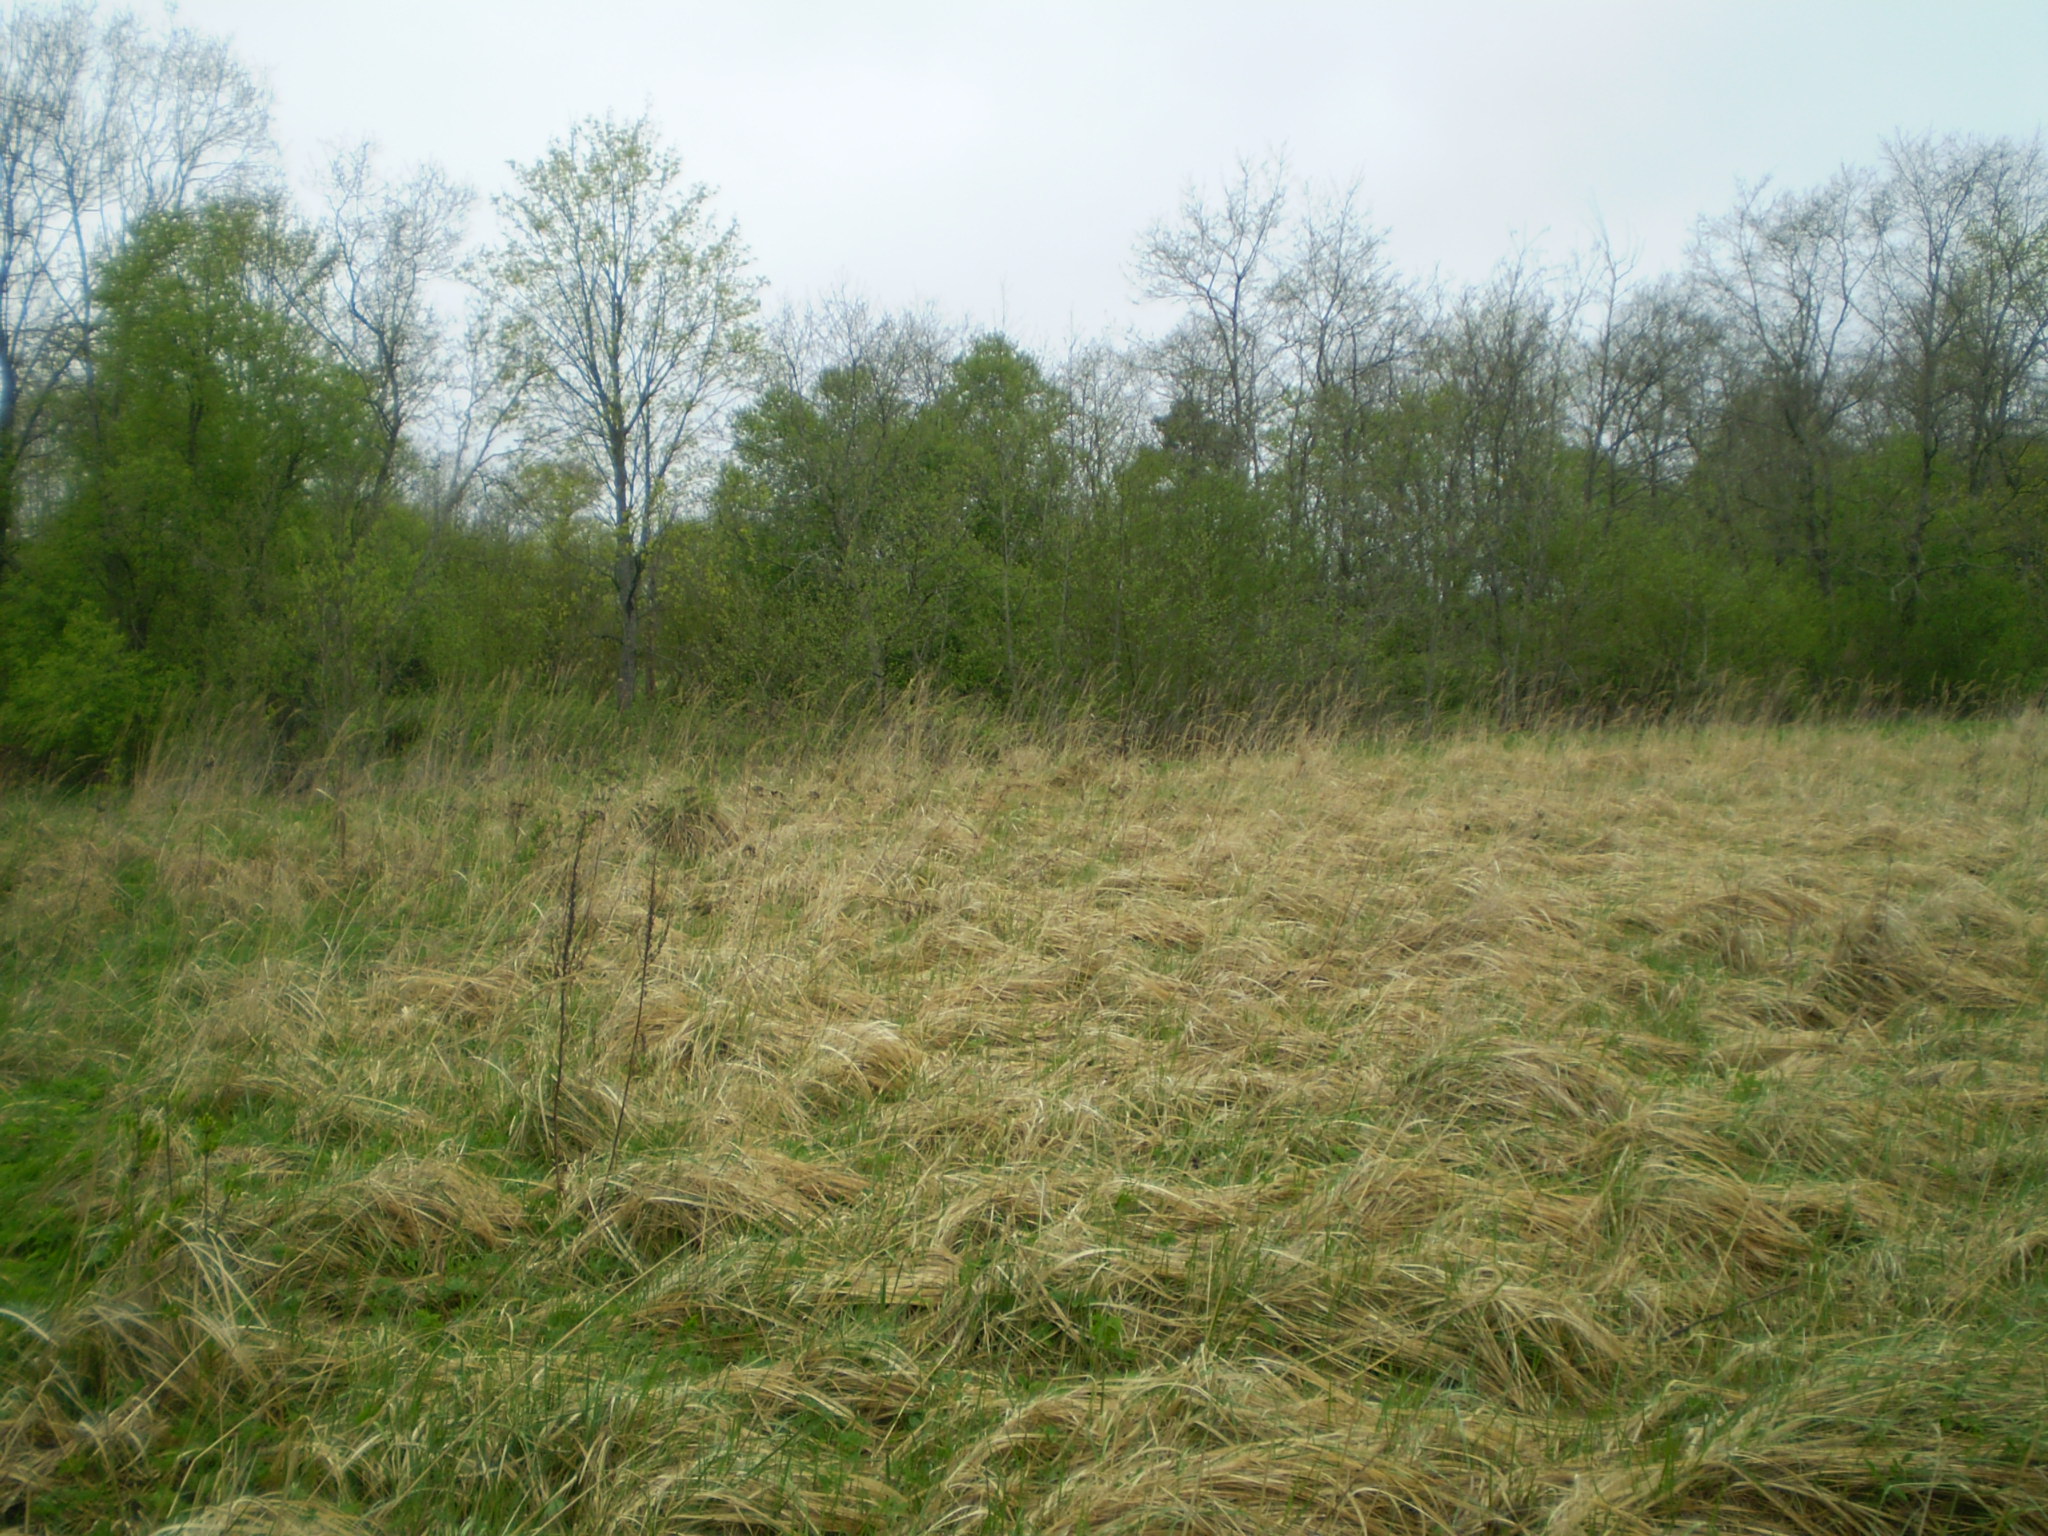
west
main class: Grassland
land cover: Spontaneously vegetated surfaces
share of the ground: > 75 %
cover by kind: herbaceous plants 100 %
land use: Abandoned areas
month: May
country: LT
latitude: 56.3198
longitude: 22.1301
